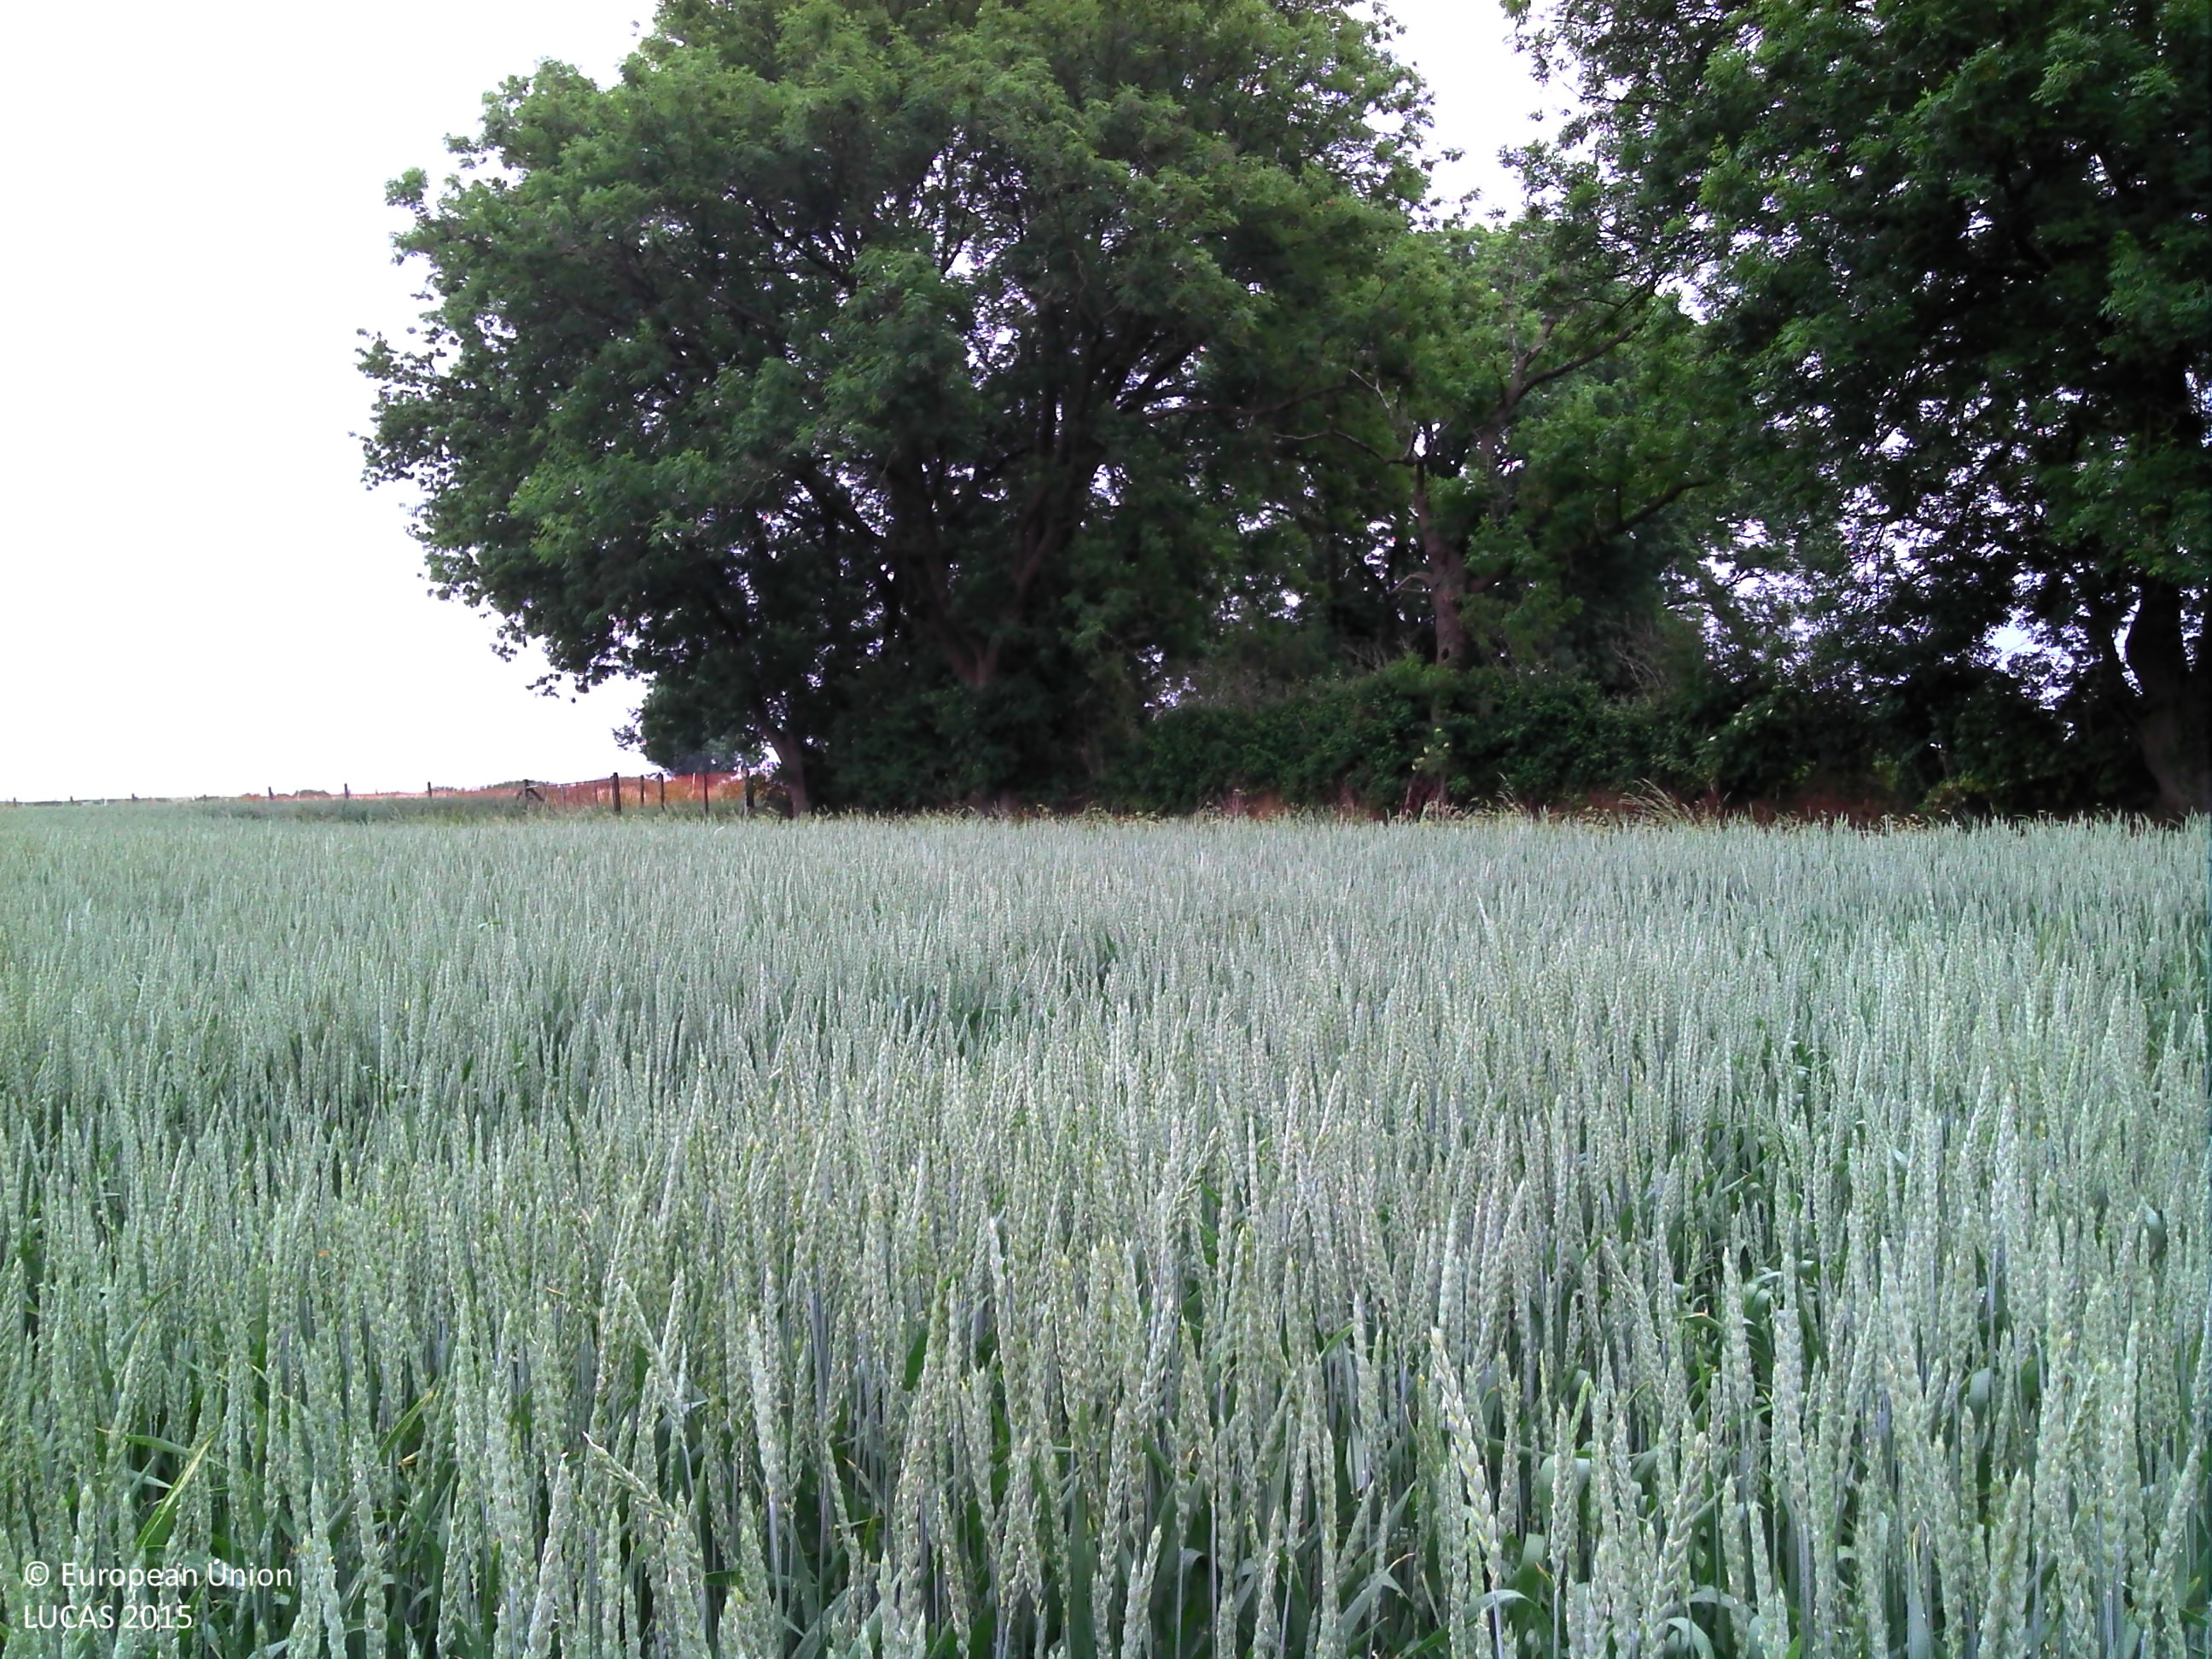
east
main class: Cropland
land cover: Other cereals
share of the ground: > 75 %
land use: Agriculture (excluding fallow land and kitchen gardens)
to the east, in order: Other cereals; Grassland without tree/shrub cover; Broadleaved woodland; Fences; Grassland without tree/shrub cover; Fences; Managed hedges; Grassland without tree/shrub cover; Fences; Grassland without tree/shrub cover; Fences; Grassland without tree/shrub cover; Fences; Grass margins; Paved roads, cycling and walking lanes; Grass margins; Managed hedges; Fences; Grassland with sparse tree/shrub cover; Grassland without tree/shrub cover; Fences; Grass margins; Common wheat
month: June
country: BE
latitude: 50.7070
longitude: 5.4809
